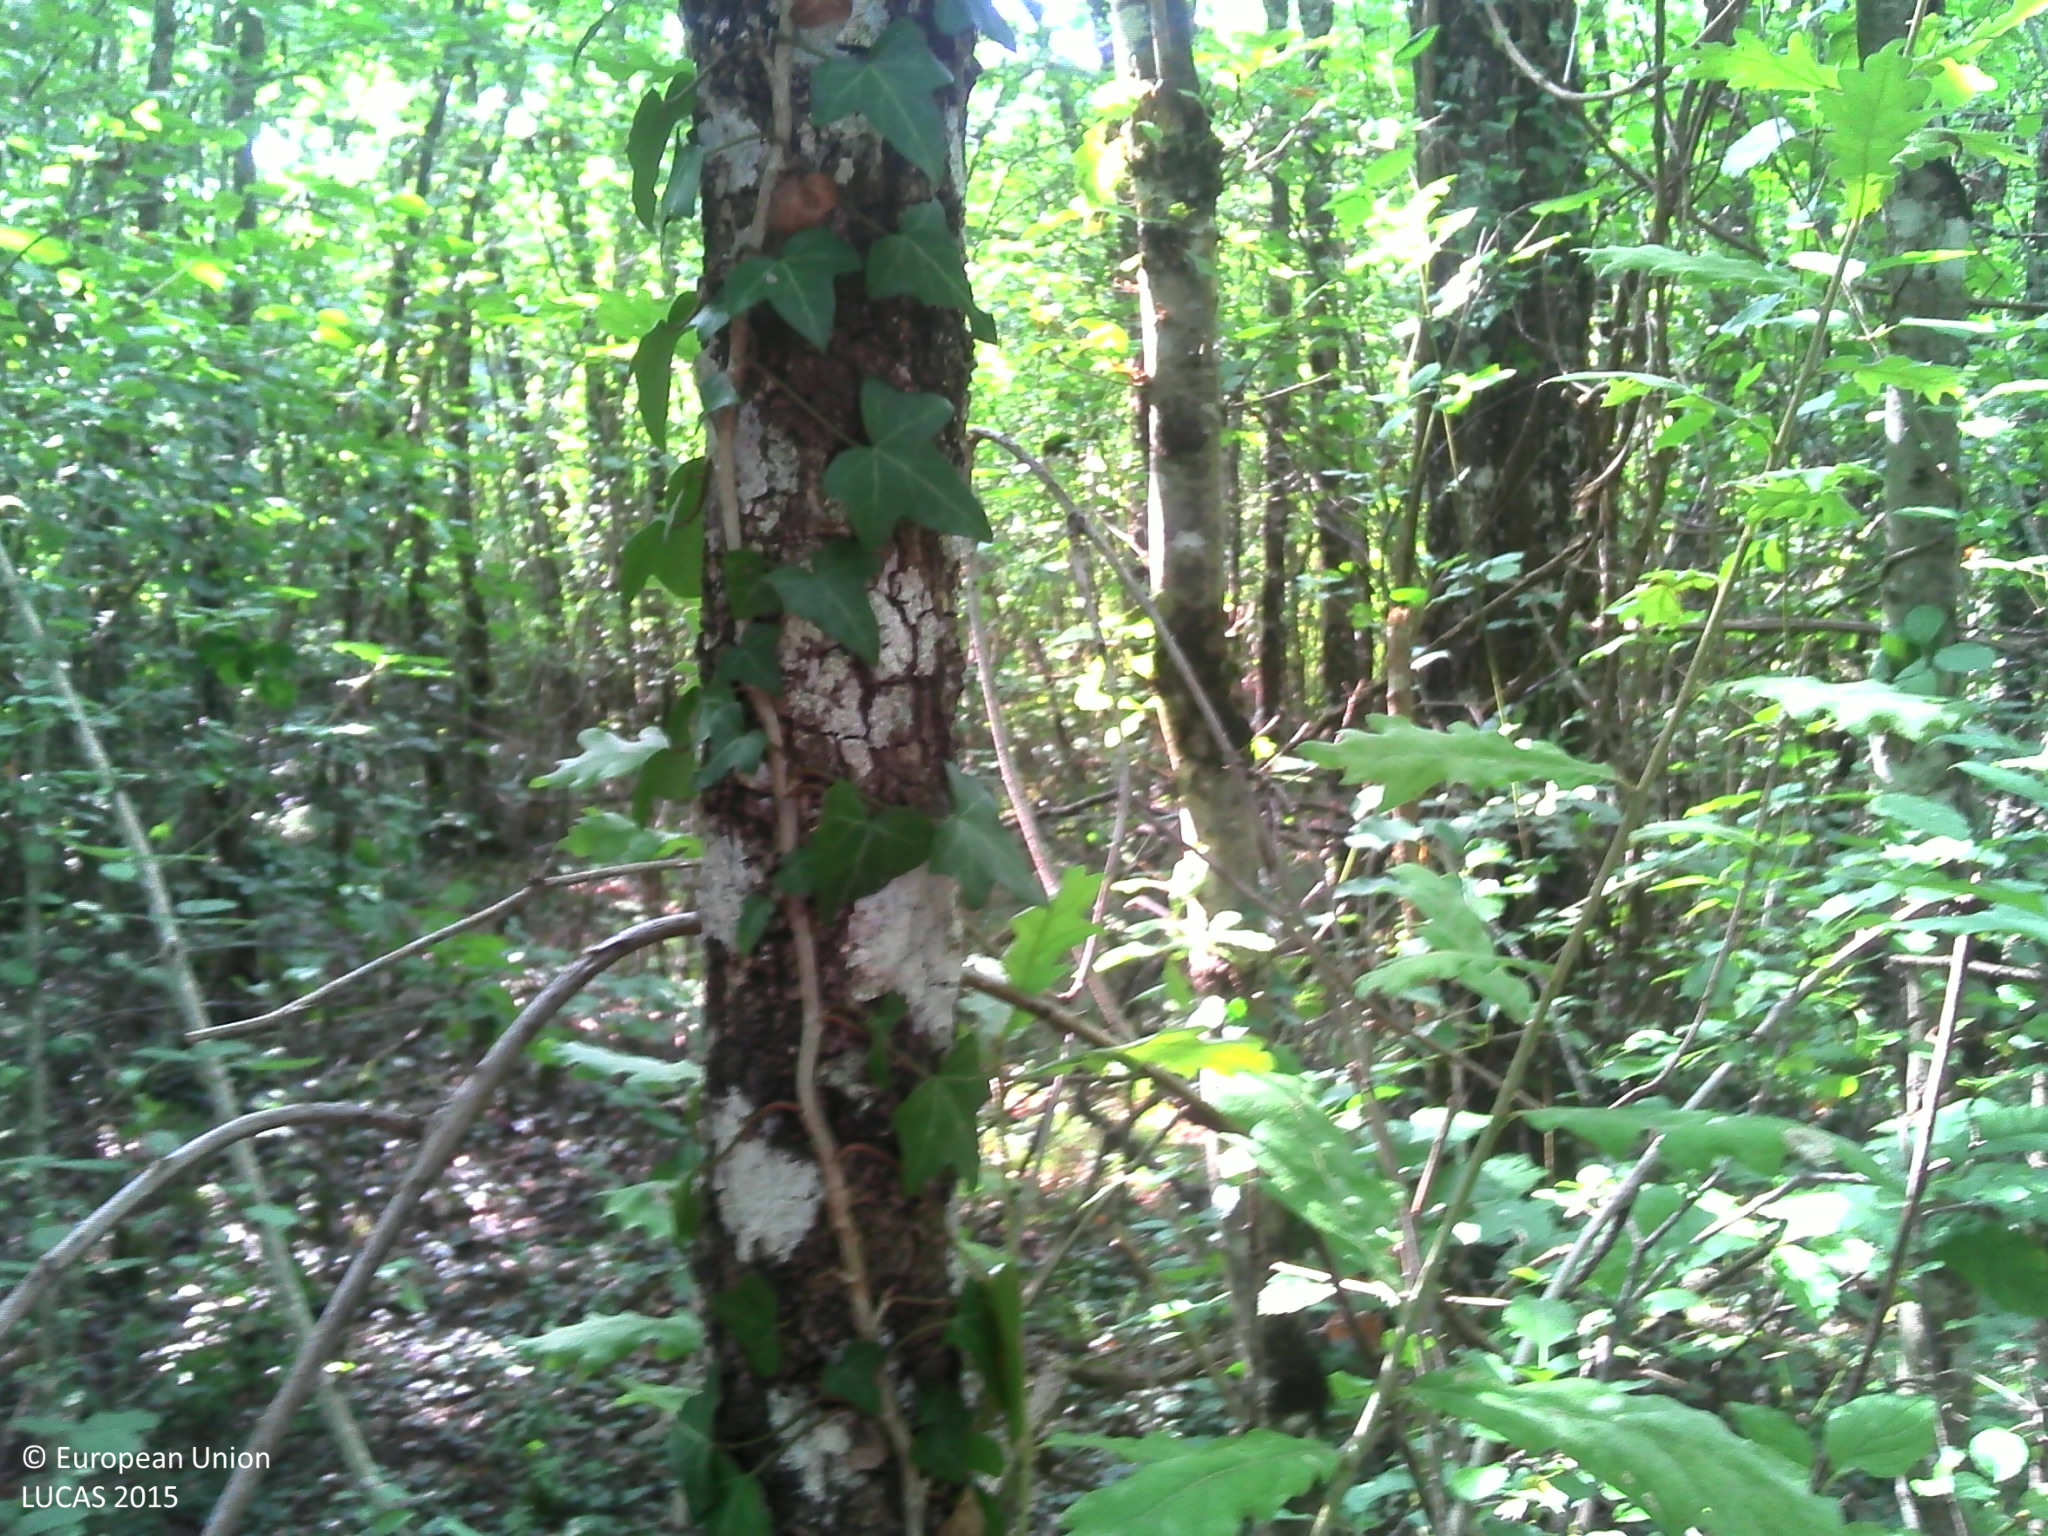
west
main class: Woodland
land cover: Broadleaved woodland
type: mesophytic deciduous forest
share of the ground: > 75 %
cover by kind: broadleaved forest trees 100 %
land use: Semi-natural and natural areas not in use
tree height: > 5 m
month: September
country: FR
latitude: 47.0737
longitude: 1.4139
